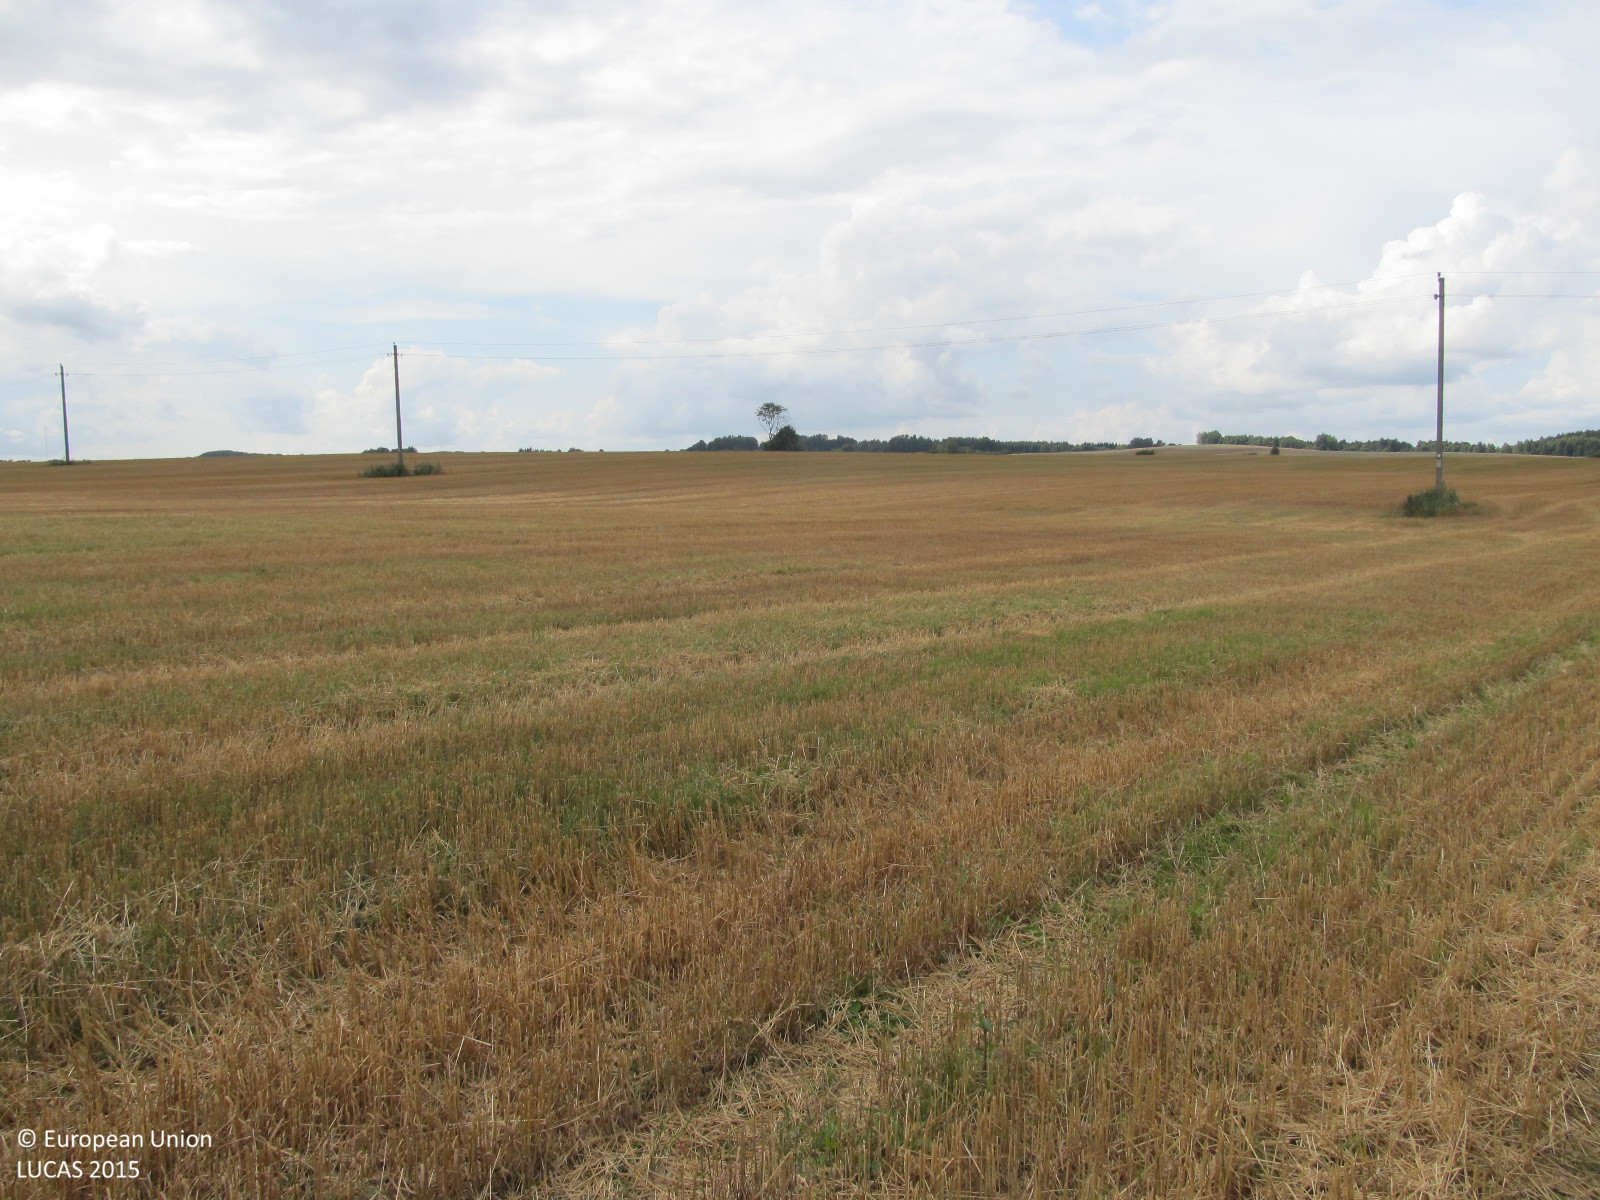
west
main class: Cropland
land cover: Common wheat
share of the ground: > 75 %
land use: Agriculture (excluding fallow land and kitchen gardens)
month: August
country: LT
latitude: 55.6868
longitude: 23.0008
